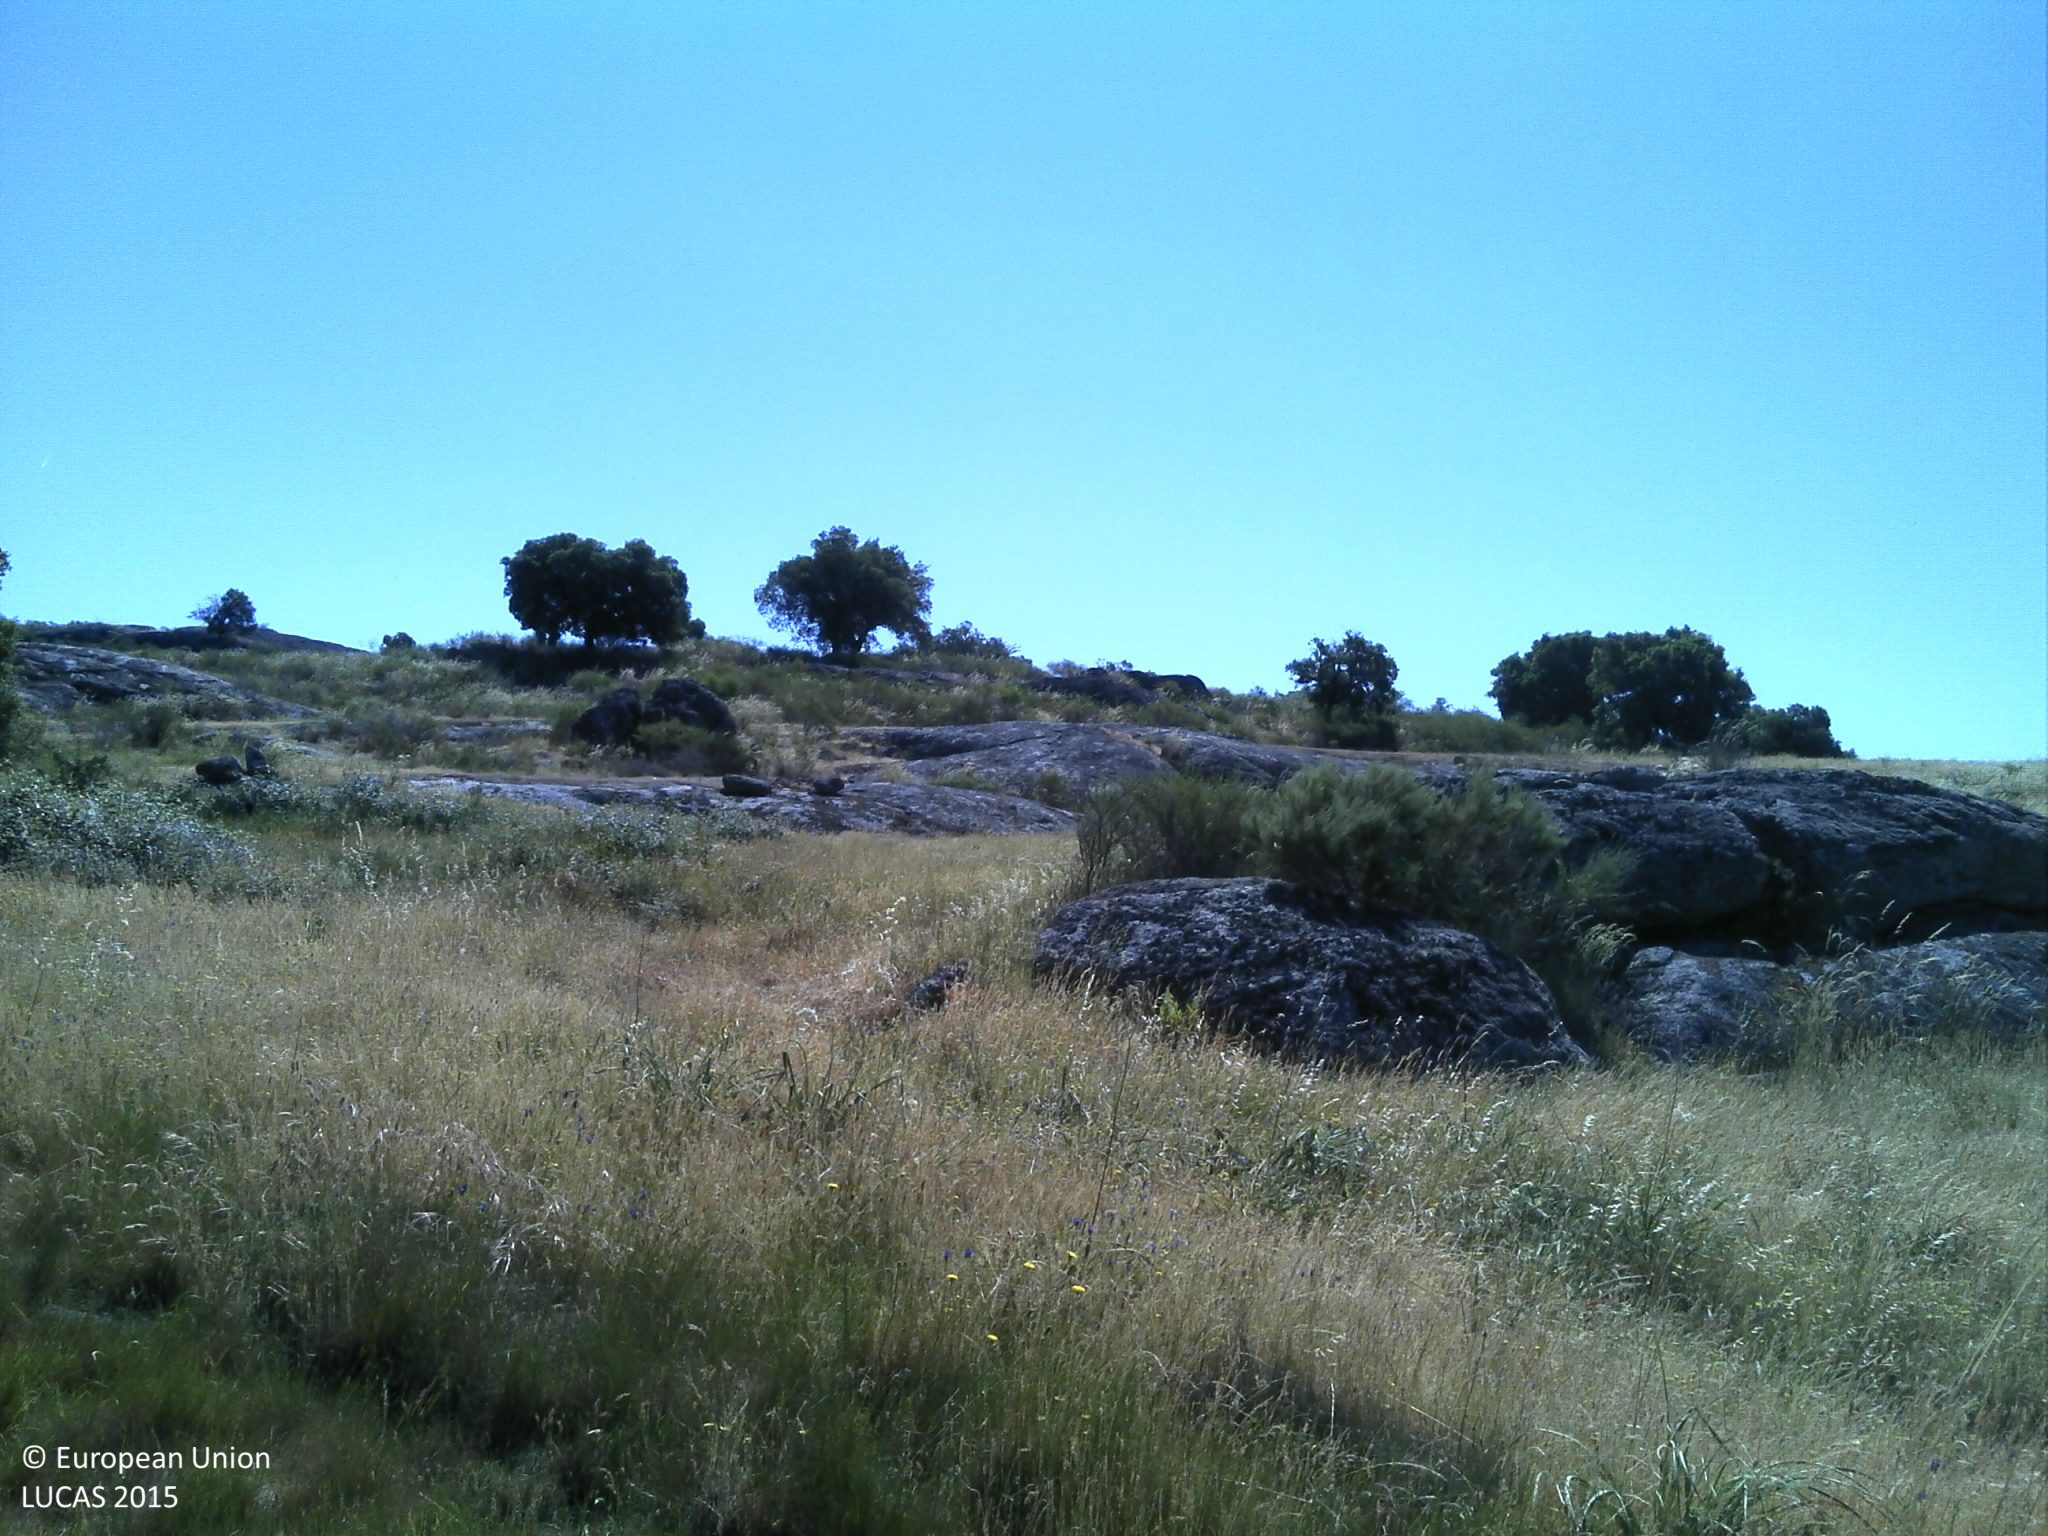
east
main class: Grassland
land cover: Grassland without tree/shrub cover
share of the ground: 25 - 50 %
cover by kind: herbaceous plants 55 %, unconsolidated bare surface 40 %, shrubs 5 %
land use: Agriculture (excluding fallow land and kitchen gardens)
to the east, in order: Grassland without tree/shrub cover; Rock outcrops; Shrubland without tree cover; Broadleaved woodland; Shrubland without tree cover; Rock outcrops; Shrubland without tree cover; Broadleaved woodland; Rock outcrops; Dry stone walls; Fences; Broadleaved woodland
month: May
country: PT
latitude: 39.4855
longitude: -7.6409
